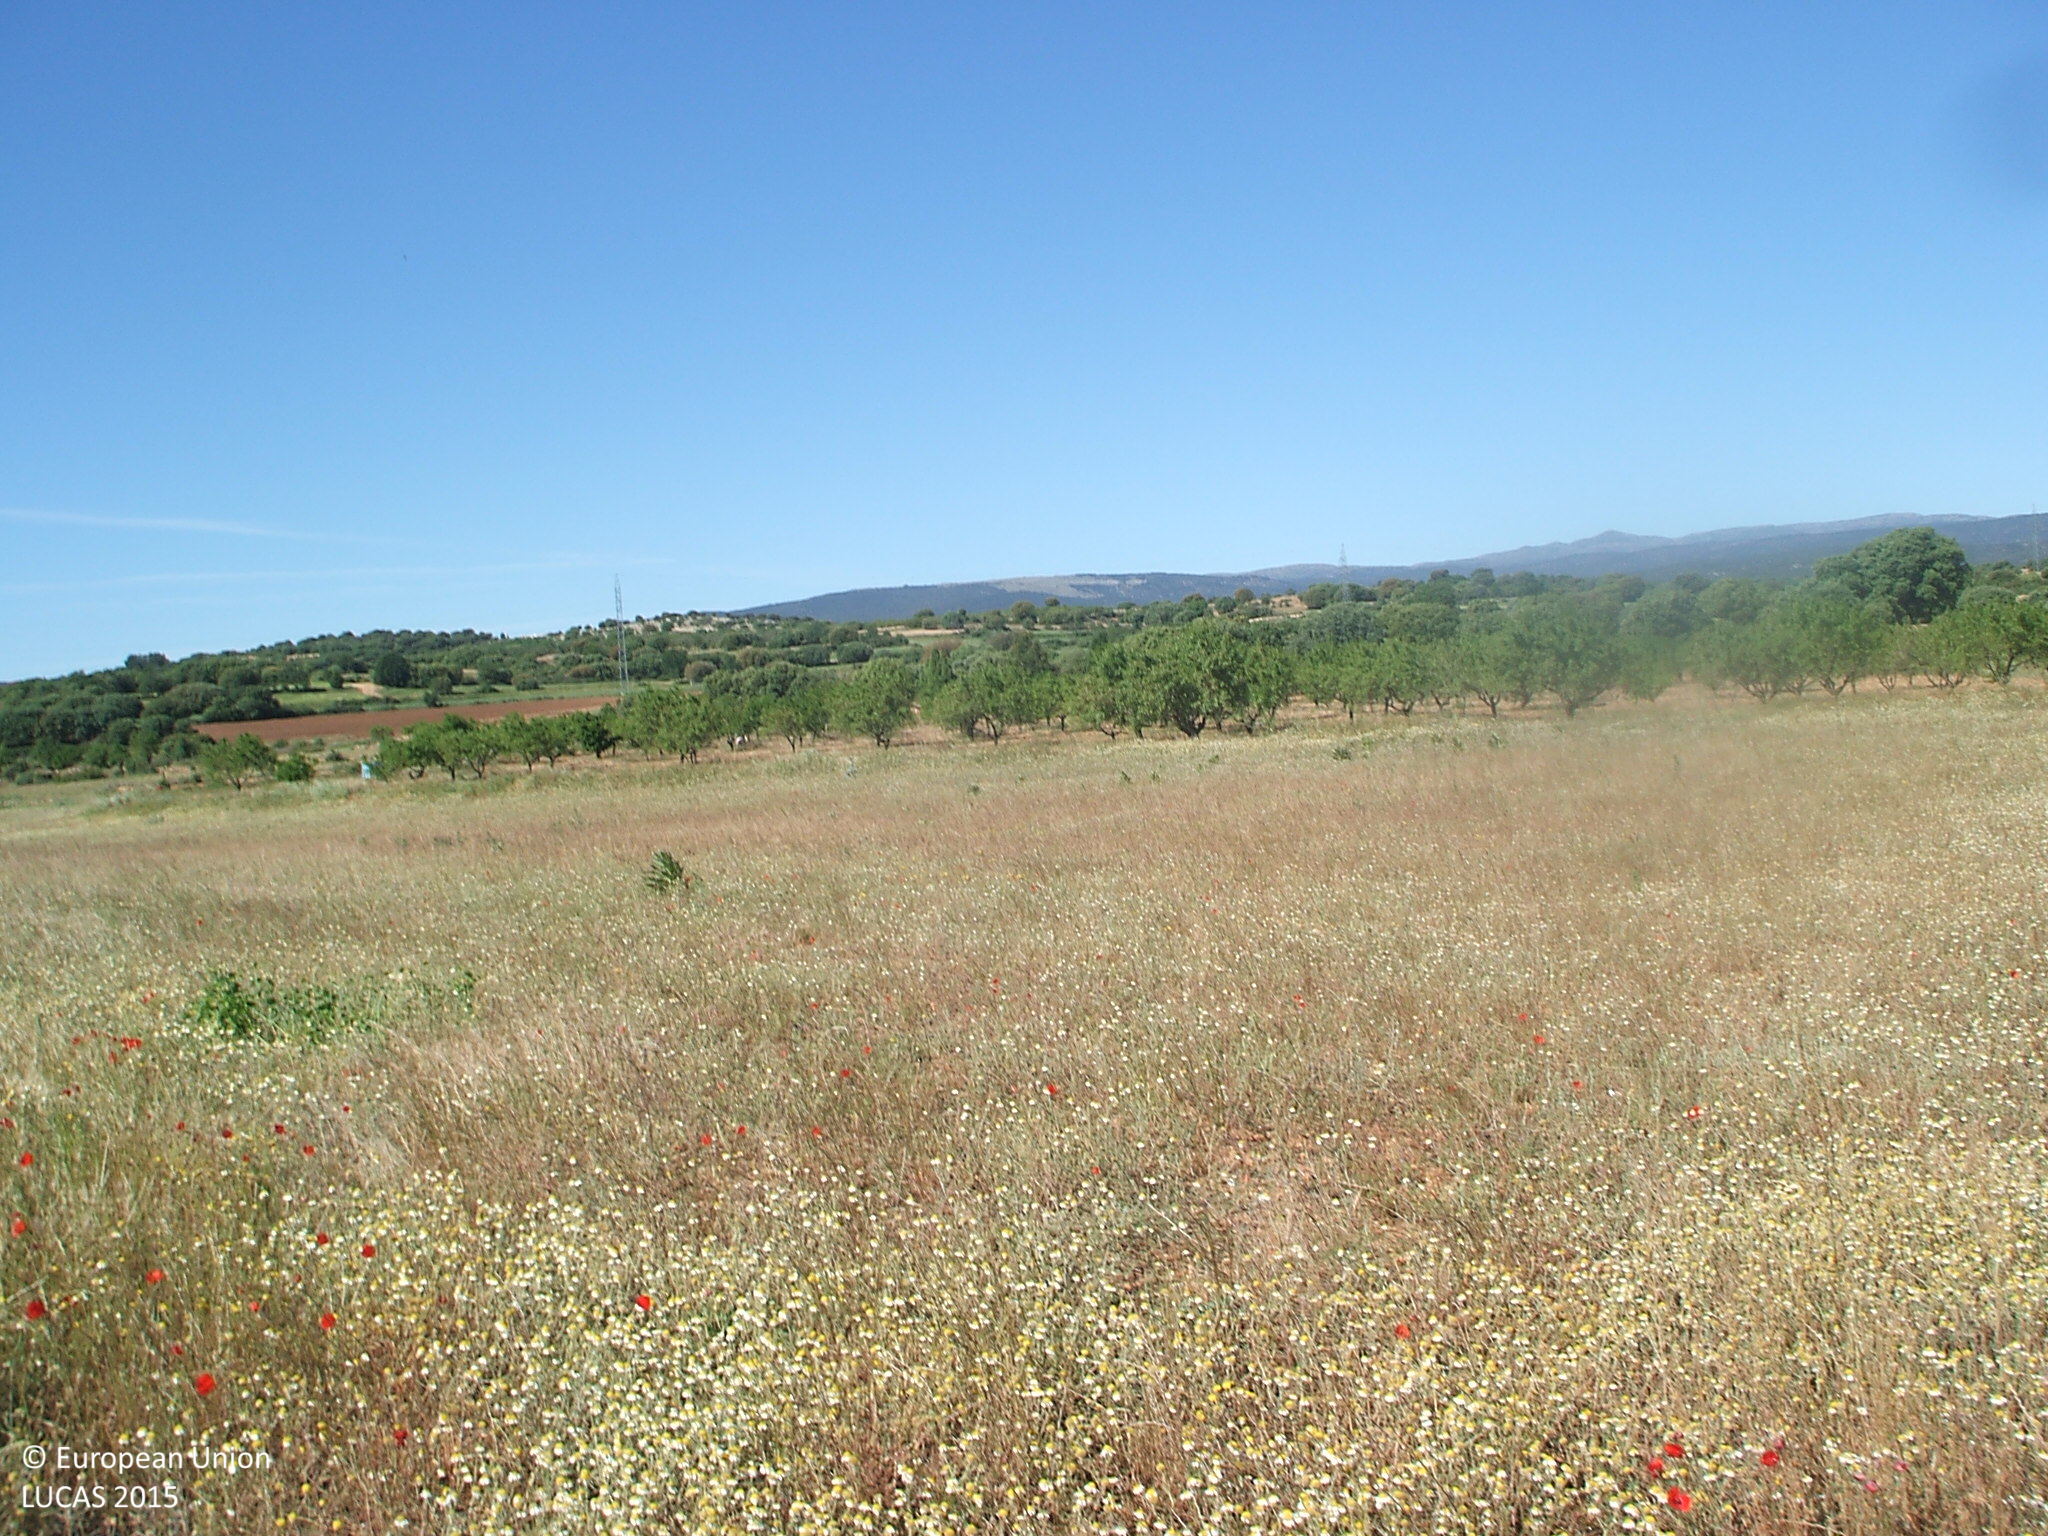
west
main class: Grassland
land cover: Spontaneously vegetated surfaces
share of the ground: > 75 %
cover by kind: herbaceous plants 100 %
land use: Fallow land
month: May
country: ES
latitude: 40.1621
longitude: -0.7968
